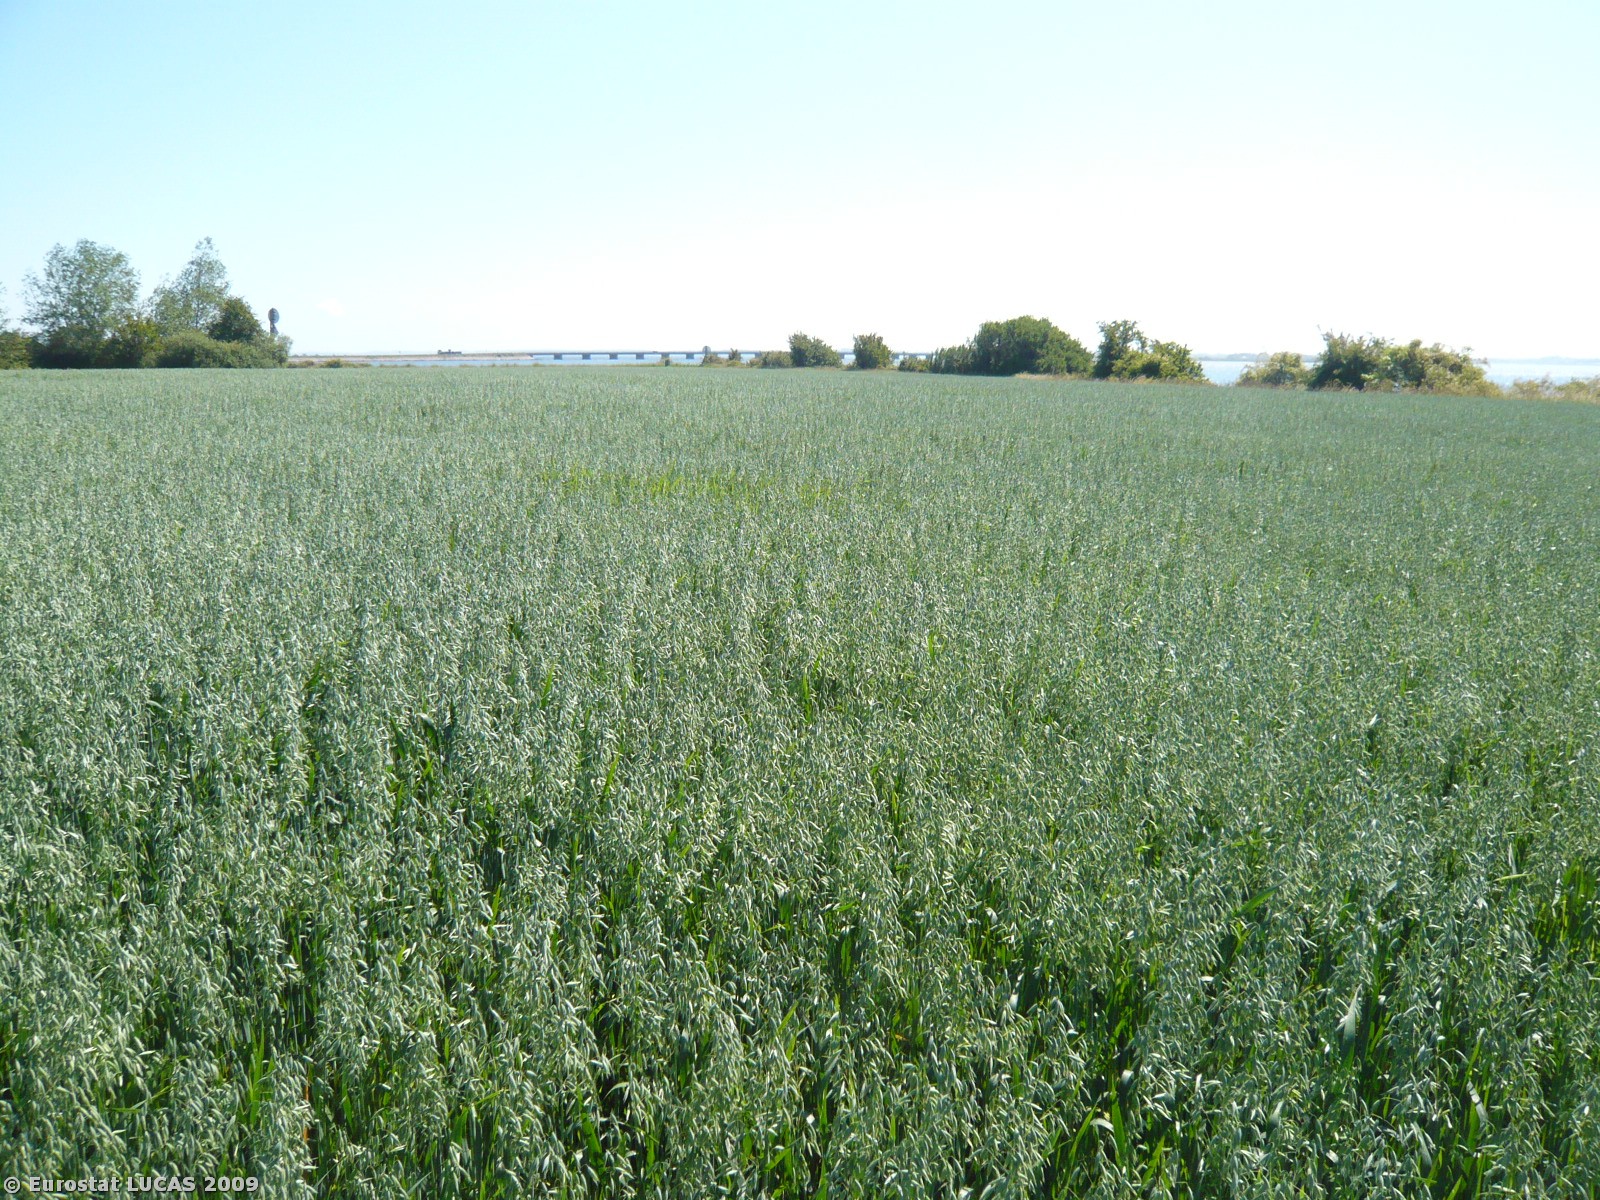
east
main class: Cropland
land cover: Oats
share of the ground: > 75 %
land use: Agriculture (excluding fallow land and kitchen gardens)
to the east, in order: Oats; Lucerne; Spontaneously vegetated surfaces; Broadleaved woodland; Spontaneously vegetated surfaces; Rock outcrops; Transitional water bodies
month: June
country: DK
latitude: 54.9639
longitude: 10.6399
